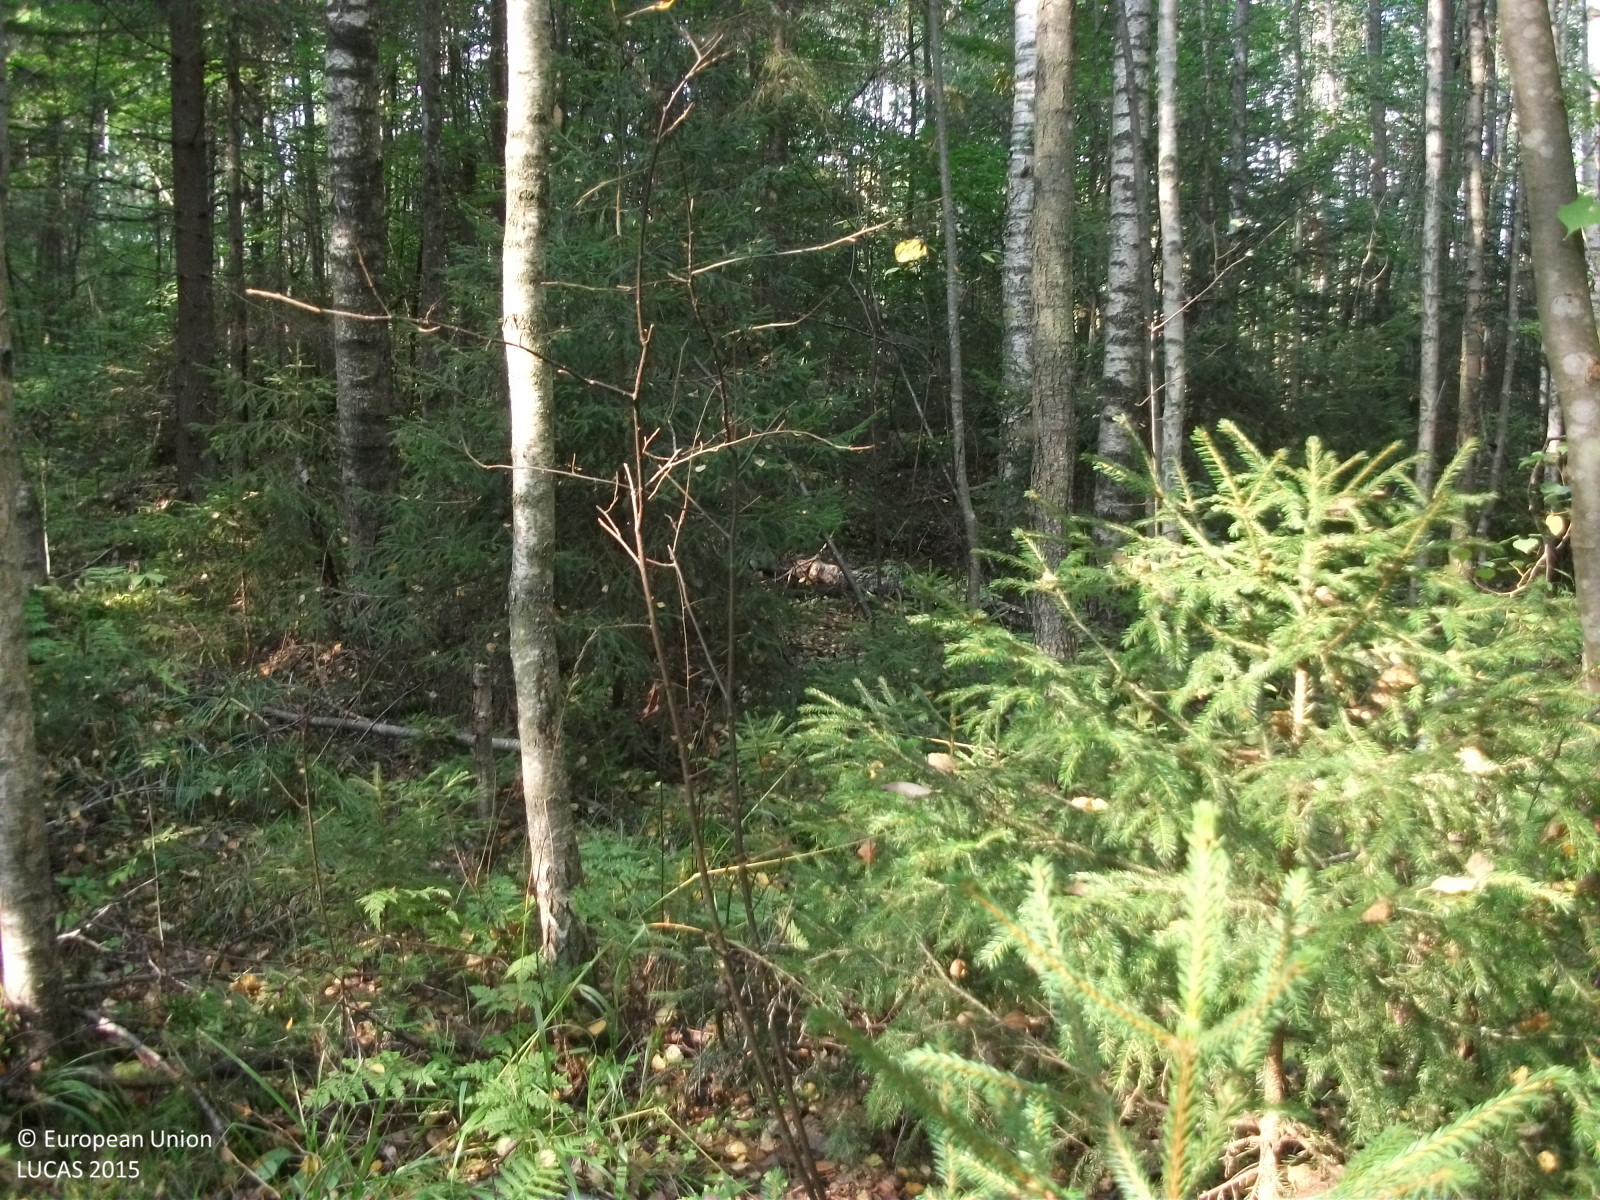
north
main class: Woodland
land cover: Spruce dominated mixed woodland
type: hemiboreal forest and nemoral coniferous forest and mixed broadleaved-coniferous forest
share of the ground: > 75 %
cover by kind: coniferous forest trees 50 %, broadleaved forest trees 30 %, herbaceous plants 10 %, shrubs 5 %, unconsolidated bare surface 5 %
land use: Forestry
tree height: > 5 m
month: September
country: LV
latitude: 57.8105
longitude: 24.5132
